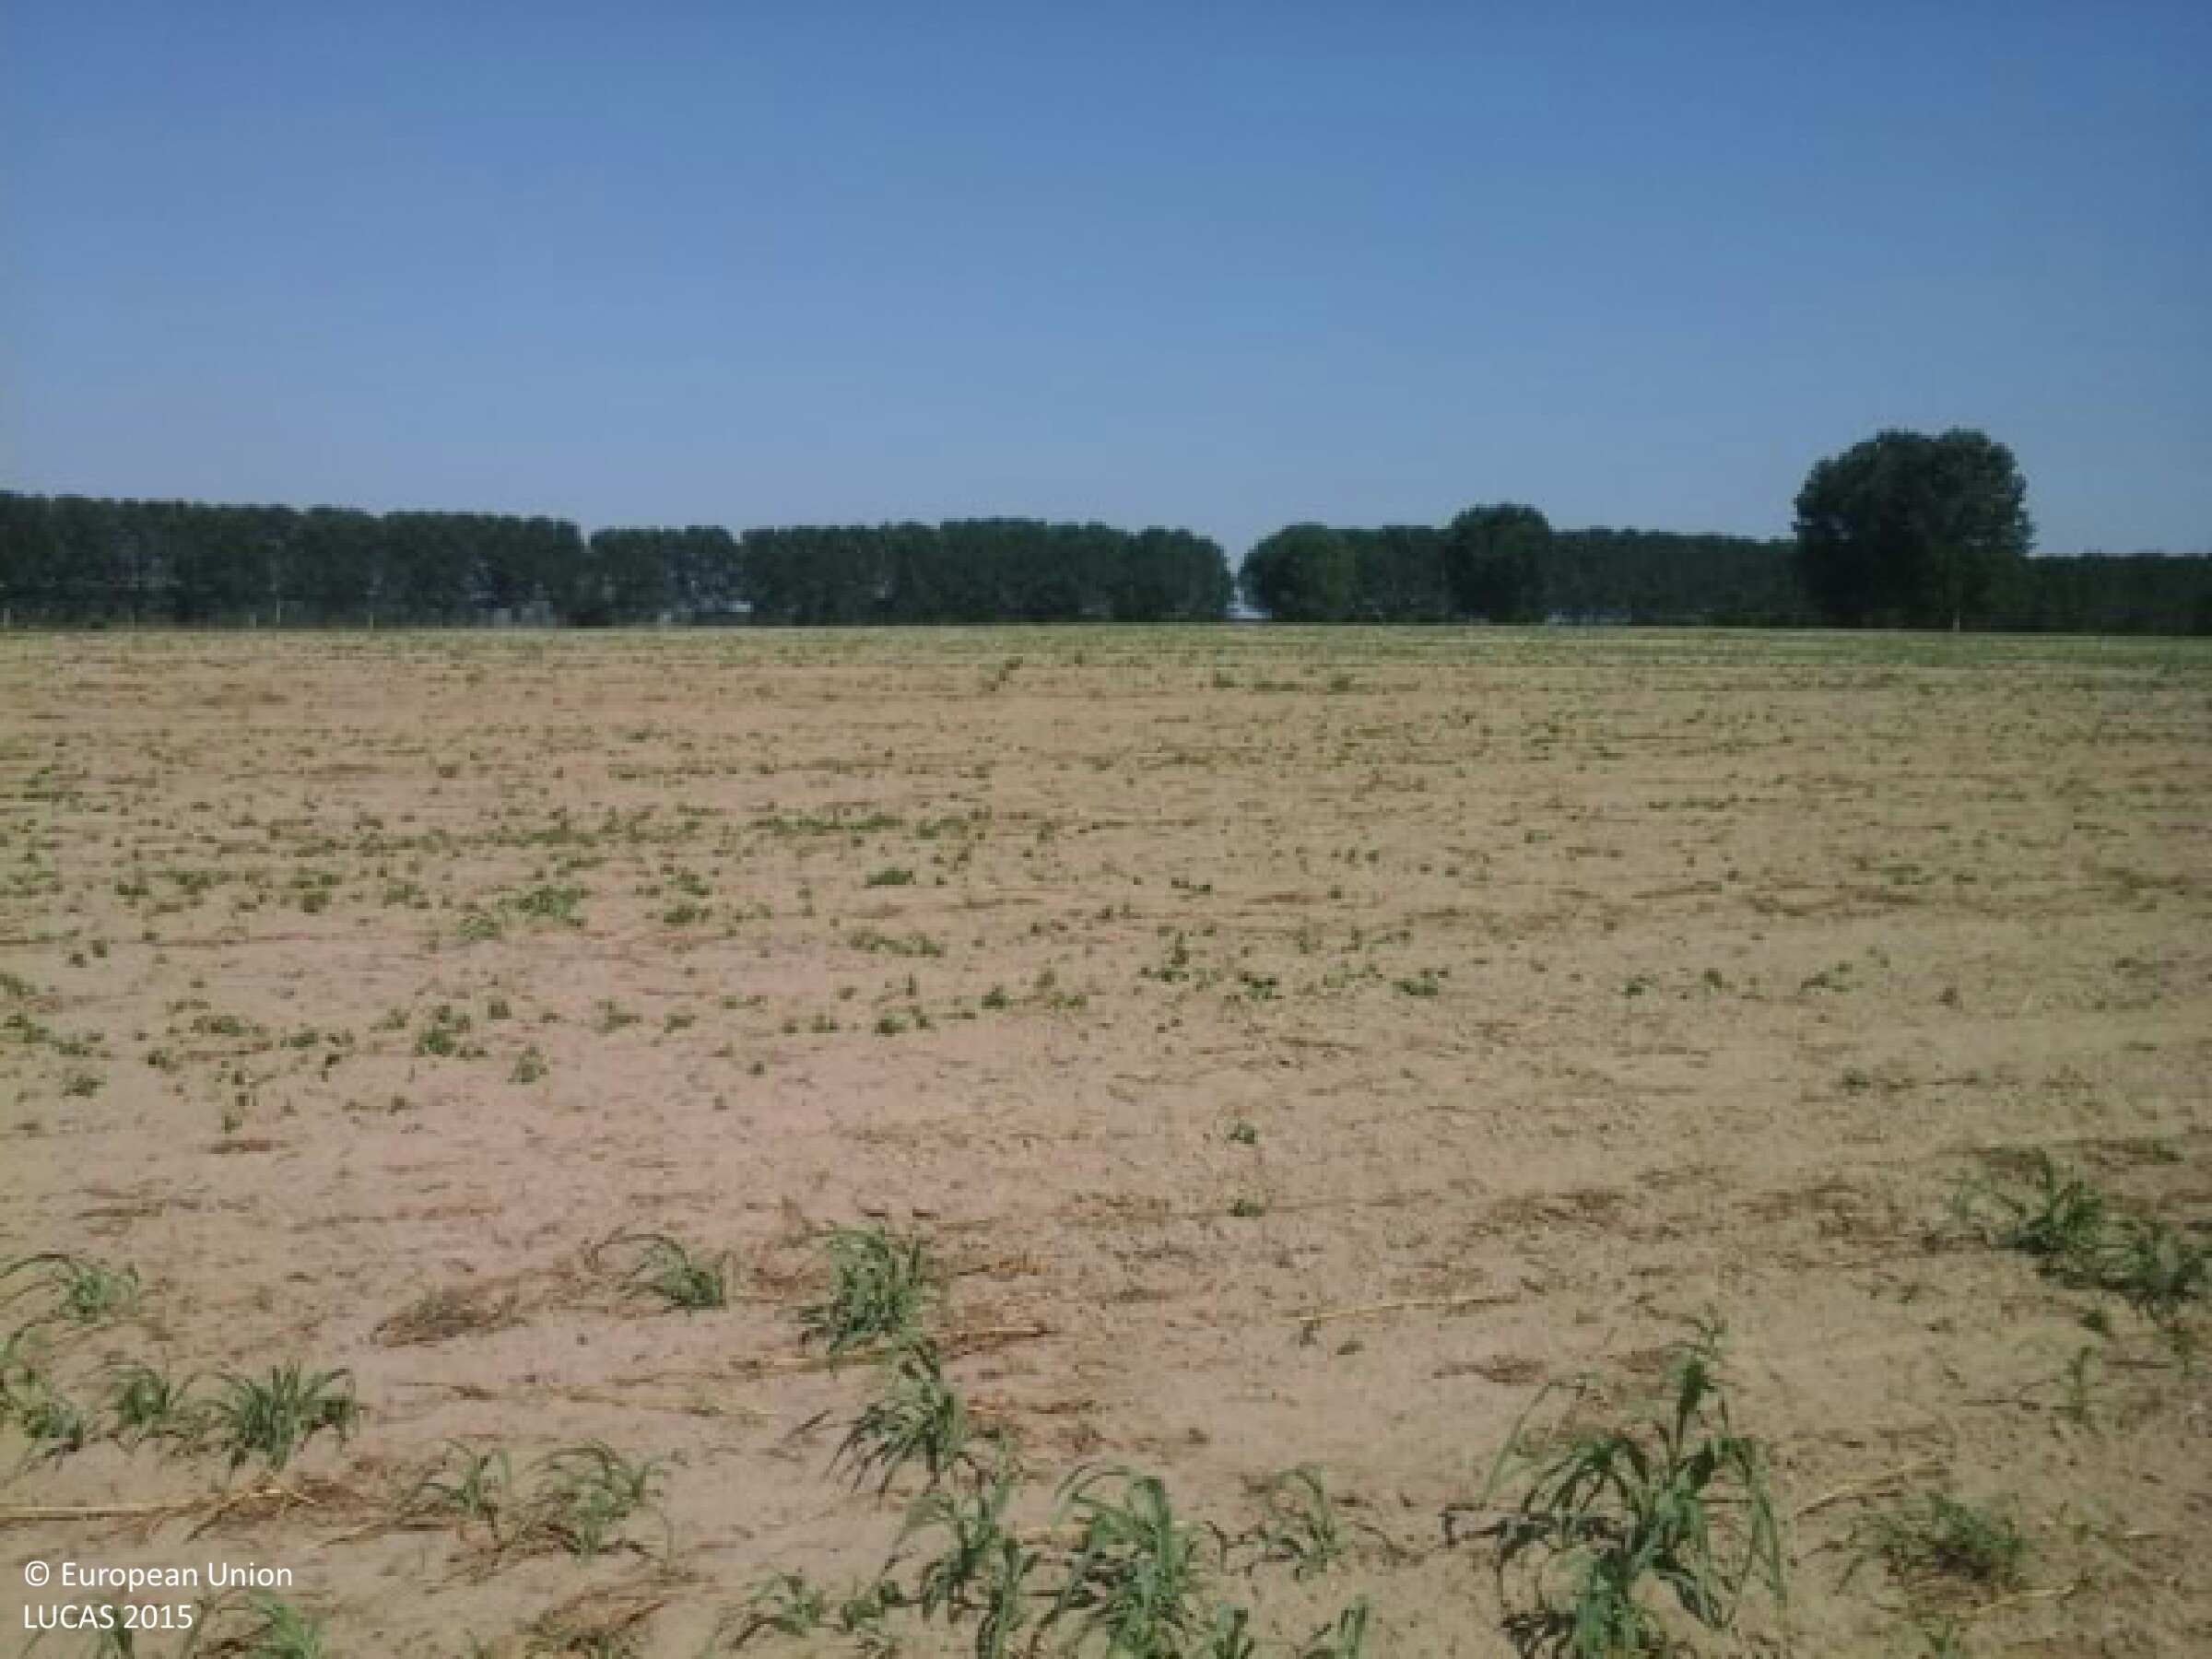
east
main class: Grassland
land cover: Spontaneously vegetated surfaces
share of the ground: 10 - 25 %
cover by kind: unconsolidated bare surface 90 %, herbaceous plants 10 %
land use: Fallow land
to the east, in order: Spontaneously vegetated surfaces
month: July
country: HU
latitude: 46.2188
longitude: 17.1715
